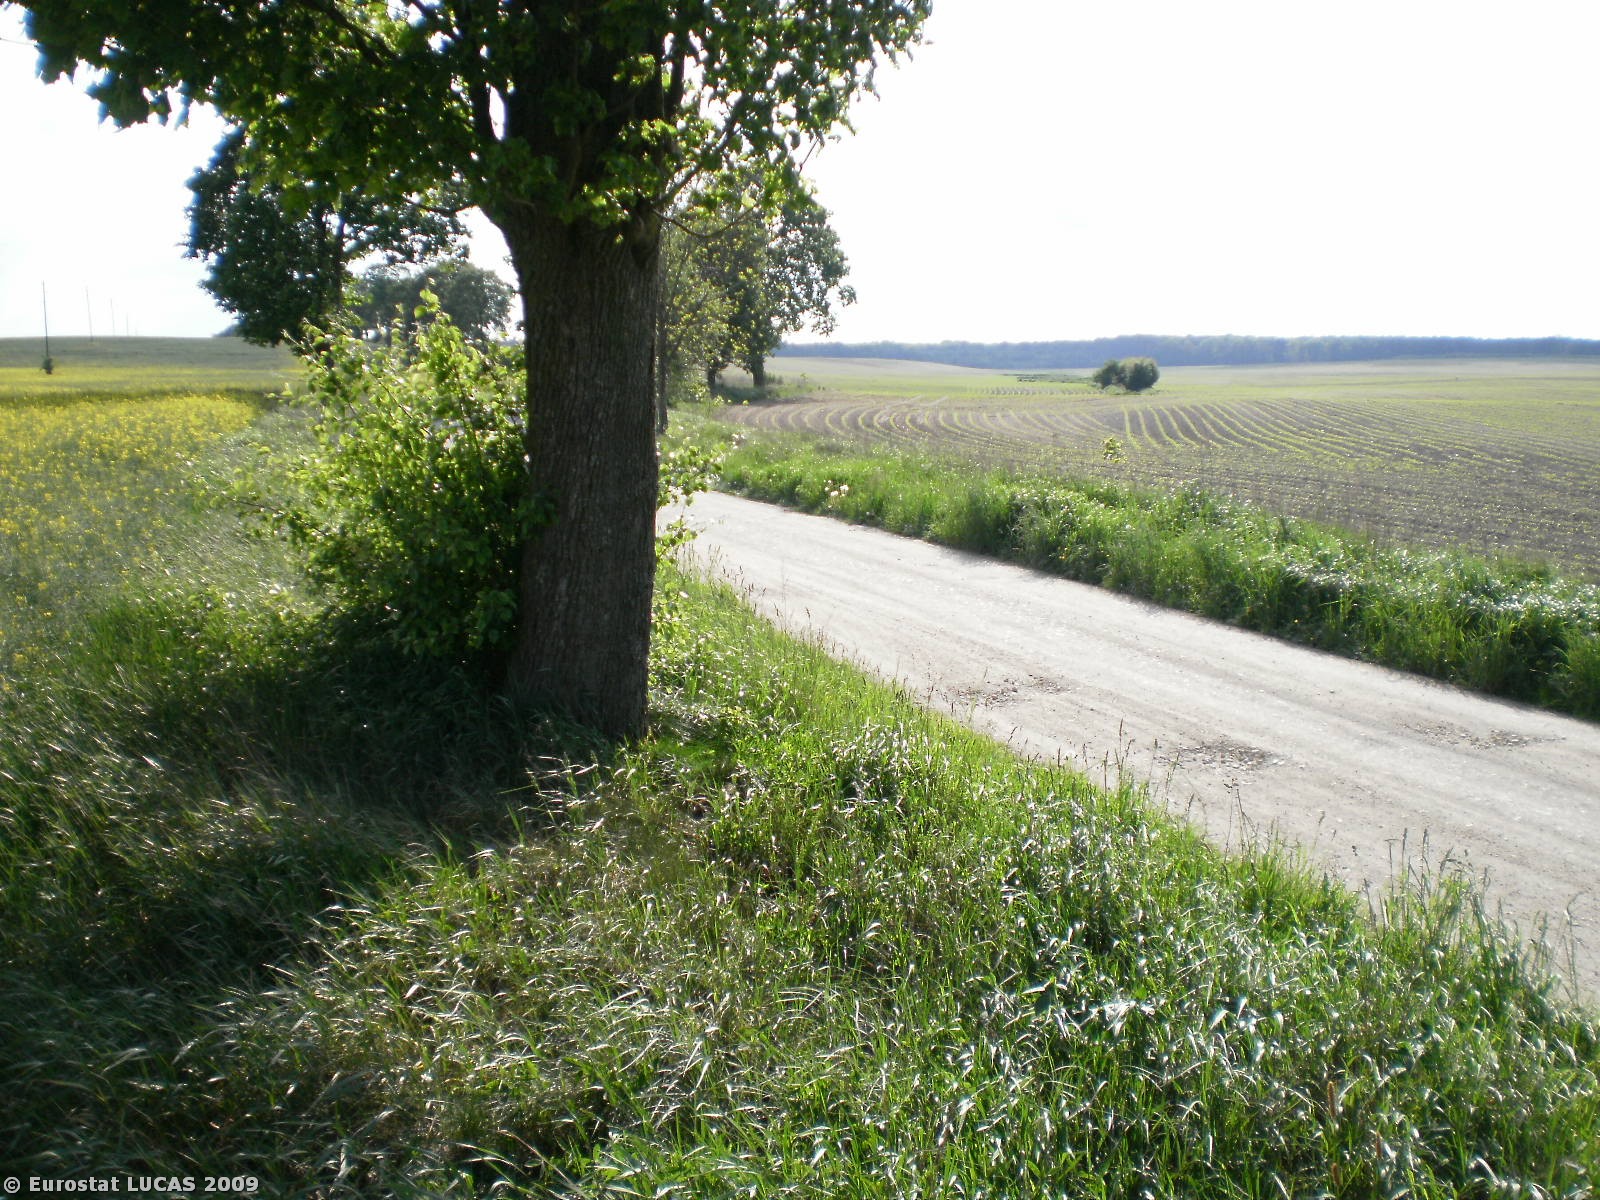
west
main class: Cropland
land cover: Rape and turnip rape
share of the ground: > 75 %
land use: Agriculture (excluding fallow land and kitchen gardens)
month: May
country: PL
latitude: 53.4649
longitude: 17.6799
